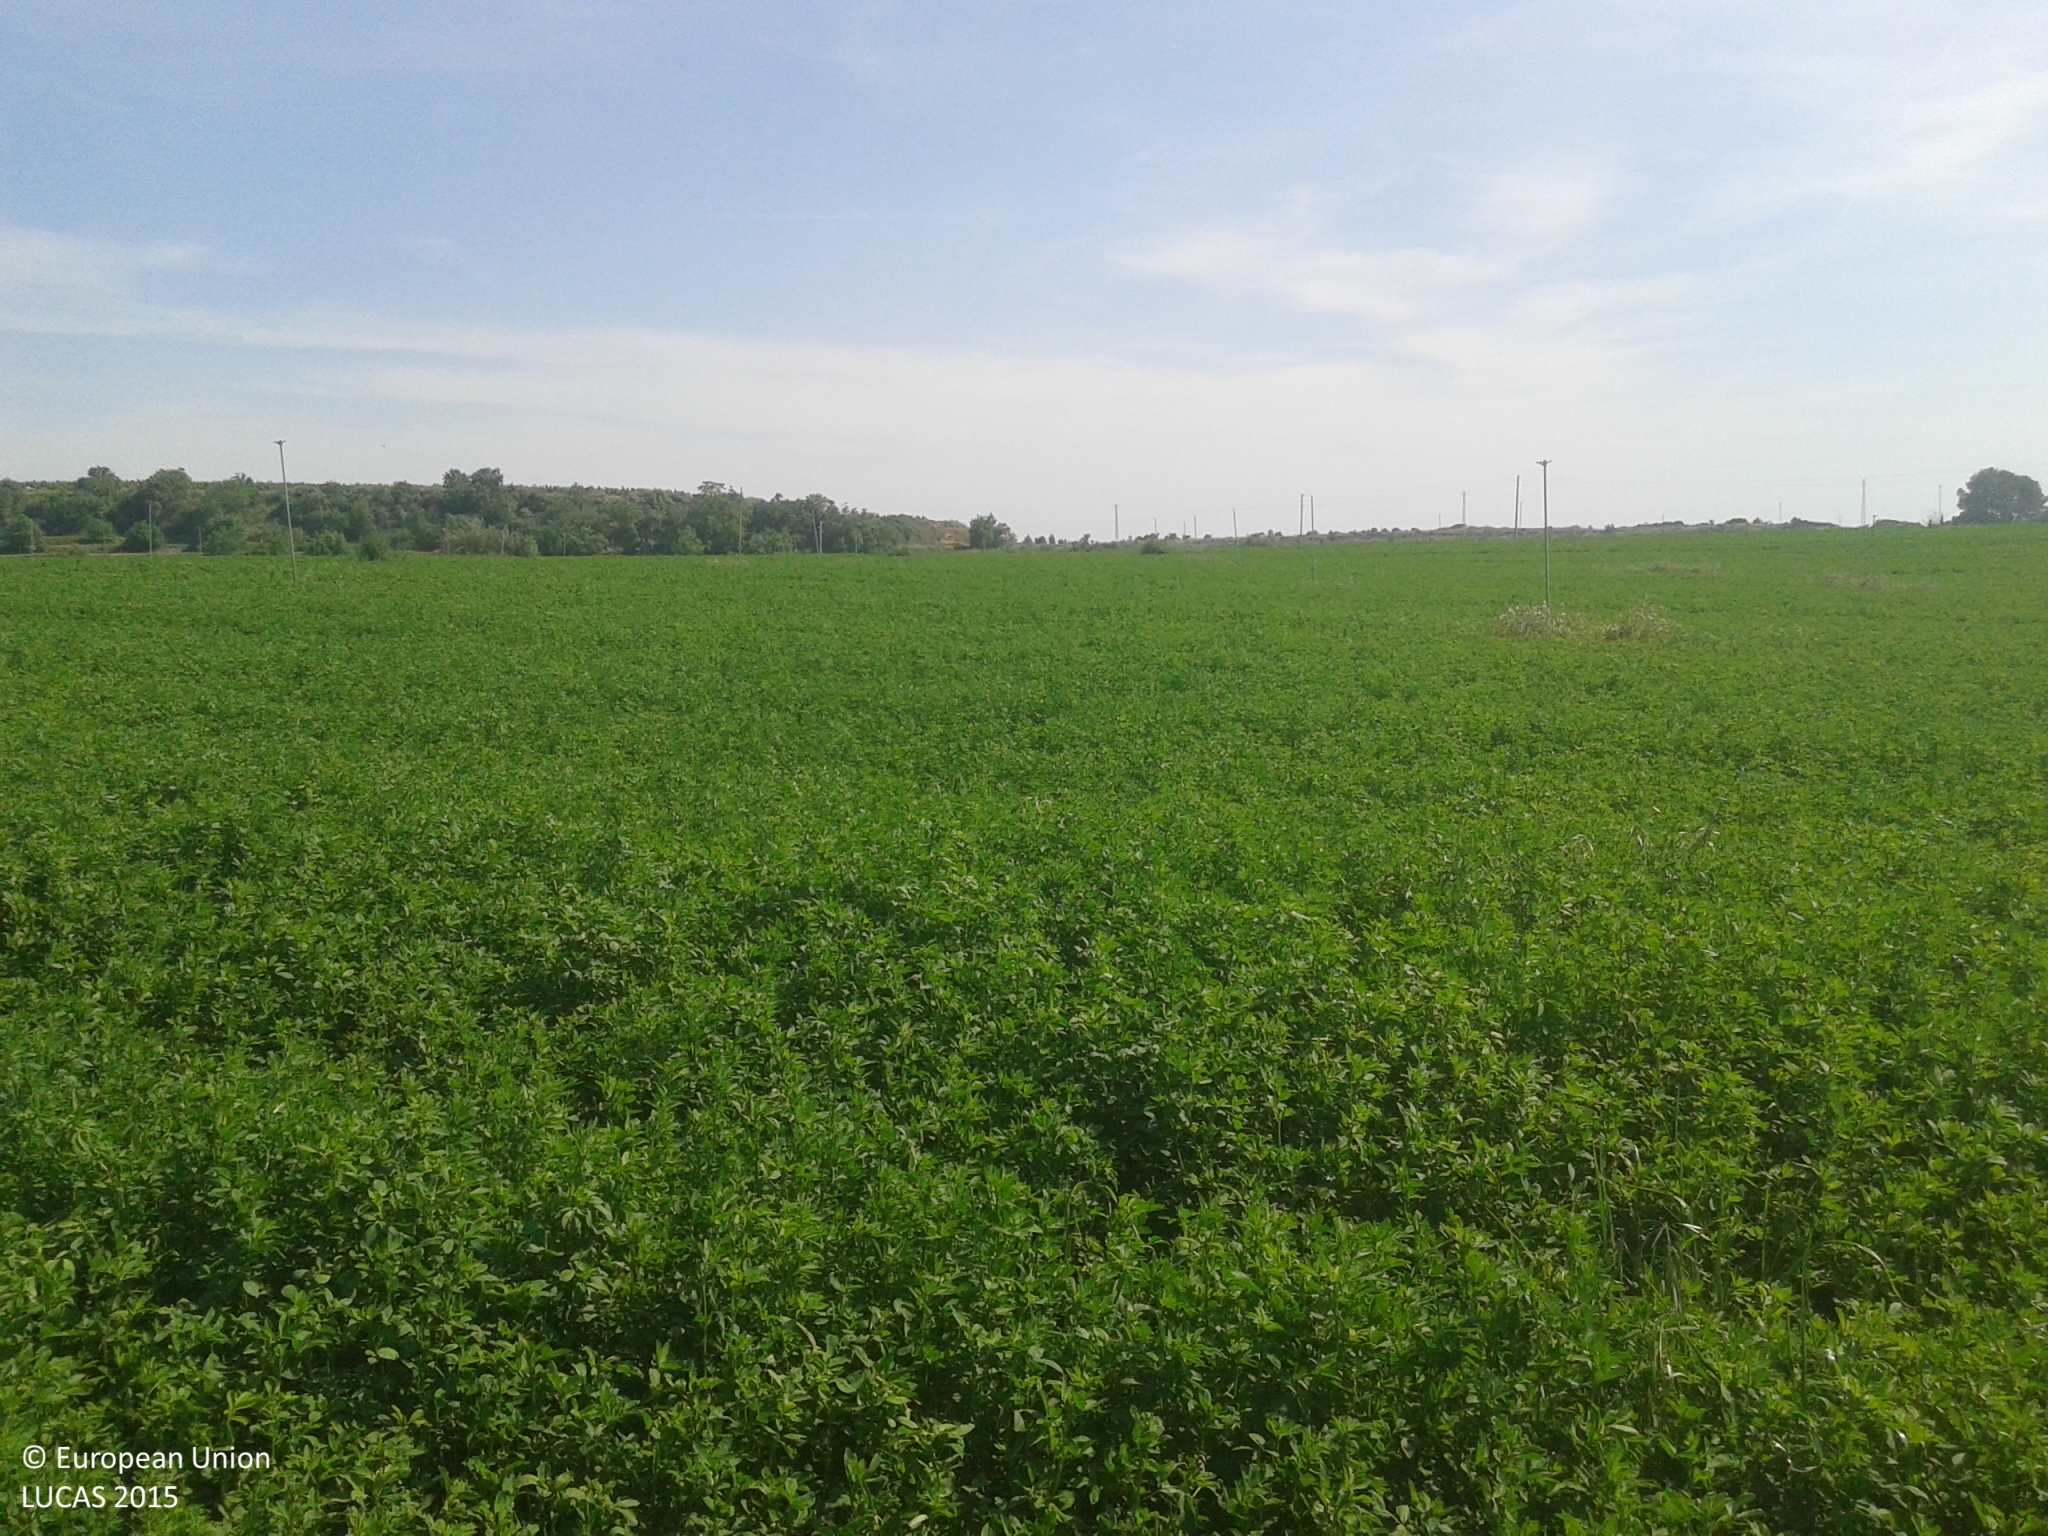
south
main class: Cropland
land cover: Lucerne
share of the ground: > 75 %
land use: Agriculture (excluding fallow land and kitchen gardens)
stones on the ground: < 10 %
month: May
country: ES
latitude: 41.8079
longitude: 0.5128
